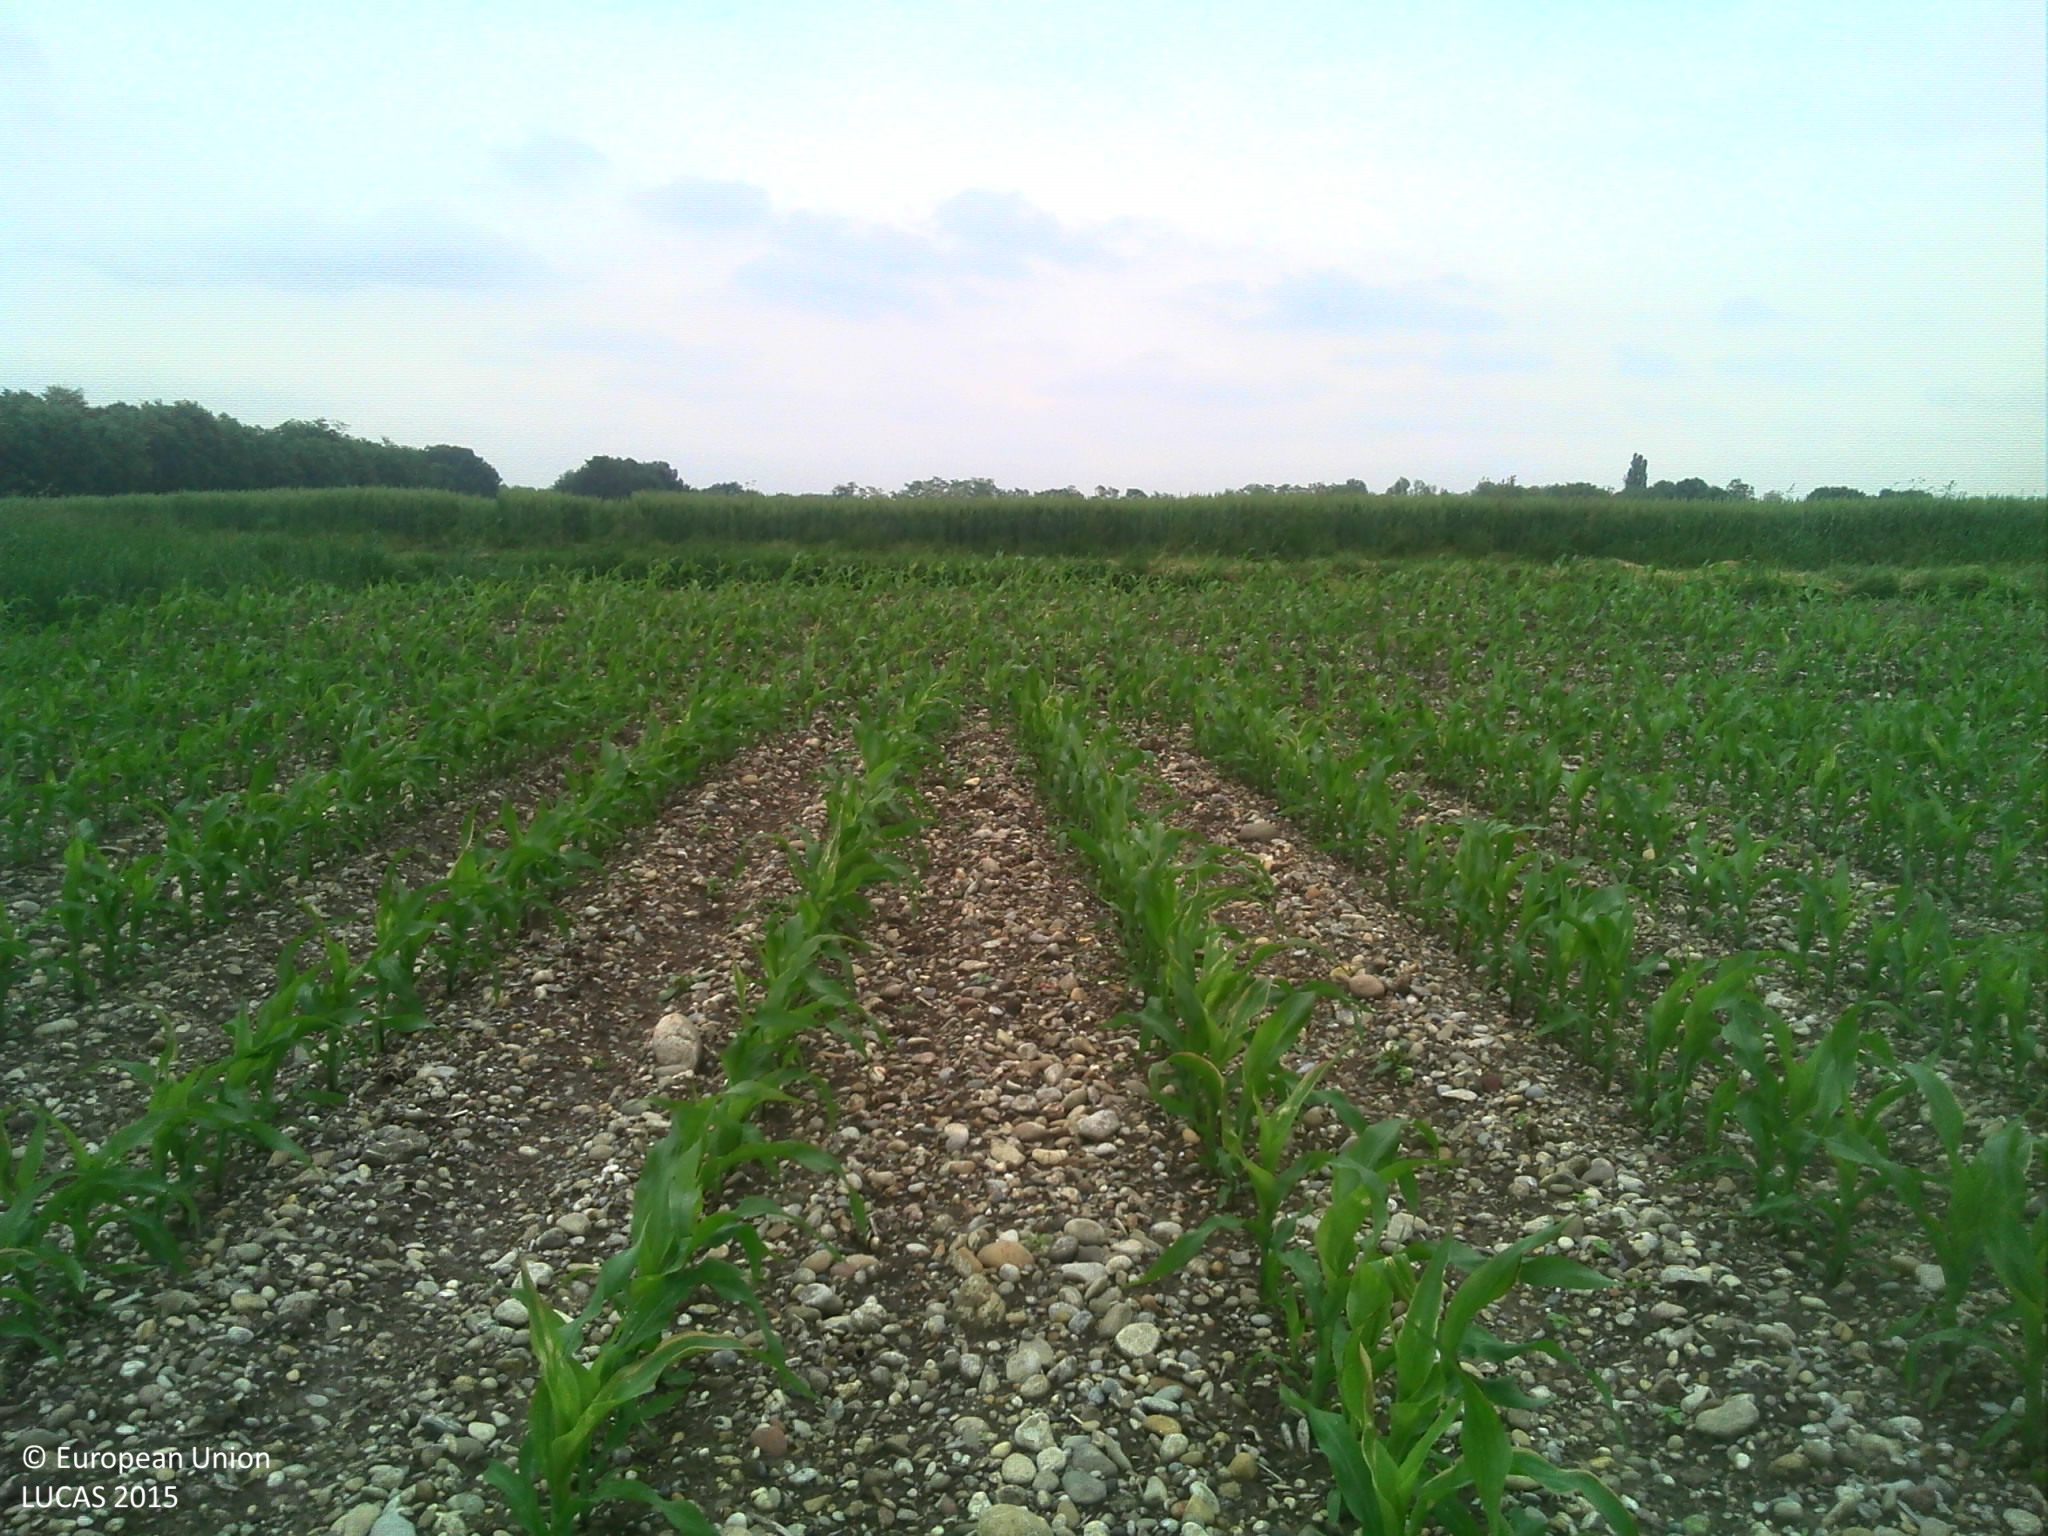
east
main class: Cropland
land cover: Maize
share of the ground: < 10 %
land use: Agriculture (excluding fallow land and kitchen gardens)
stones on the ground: > 50 %
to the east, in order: Maize; Grass margins; Tracks; Grass margins; Common wheat
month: May
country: FR
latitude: 48.2878
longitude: 7.6155
